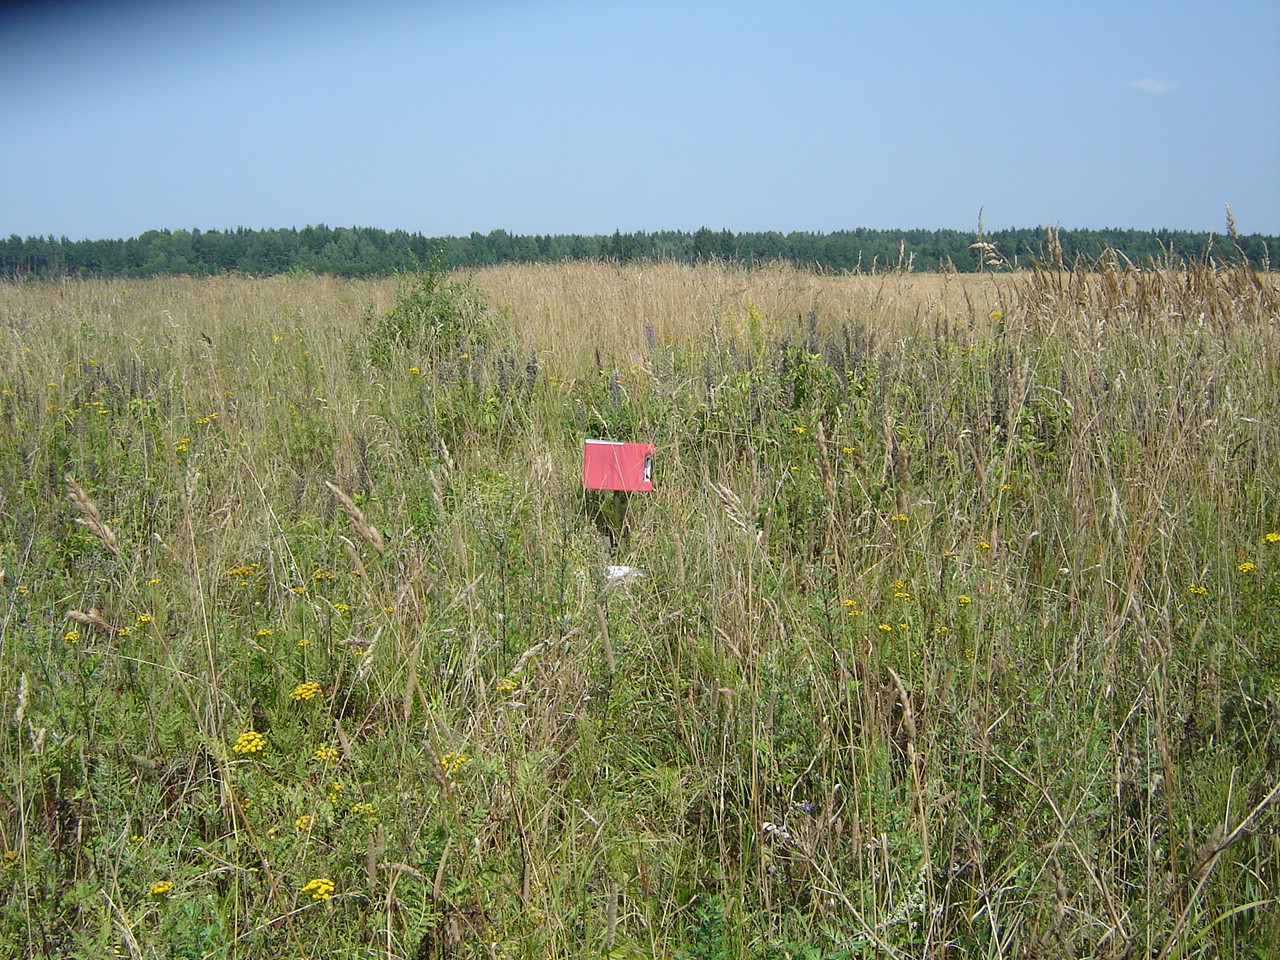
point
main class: Grassland
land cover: Spontaneously vegetated surfaces
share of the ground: > 75 %
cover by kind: herbaceous plants 100 %
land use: Fallow land
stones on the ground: < 10 %
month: August
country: LT
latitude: 55.0177
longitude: 25.0508
